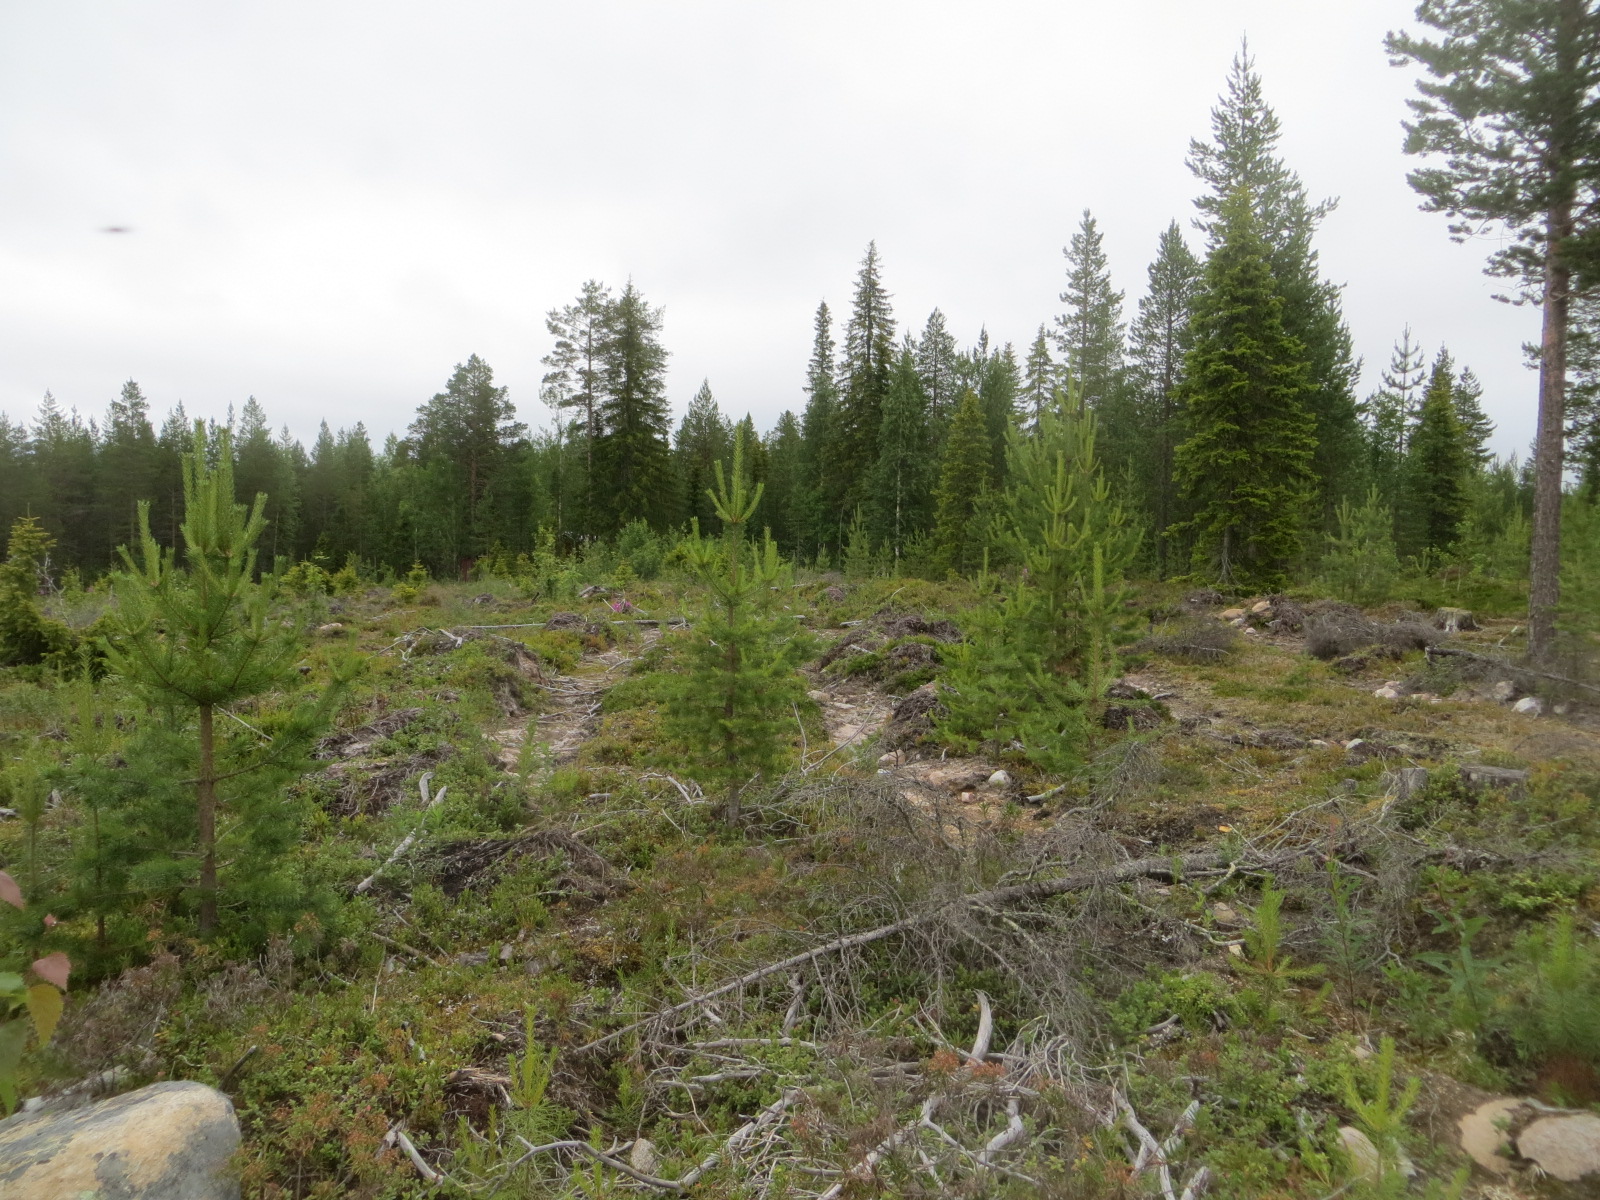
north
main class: Woodland
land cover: Pine dominated coniferous woodland
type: boreal forest
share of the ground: 25 - 50 %
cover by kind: shrubs 70 %, coniferous forest trees 25 %, broadleaved forest trees 5 %
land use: Forestry
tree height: < 5 m
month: July
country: FI
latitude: 66.4296
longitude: 24.4093
